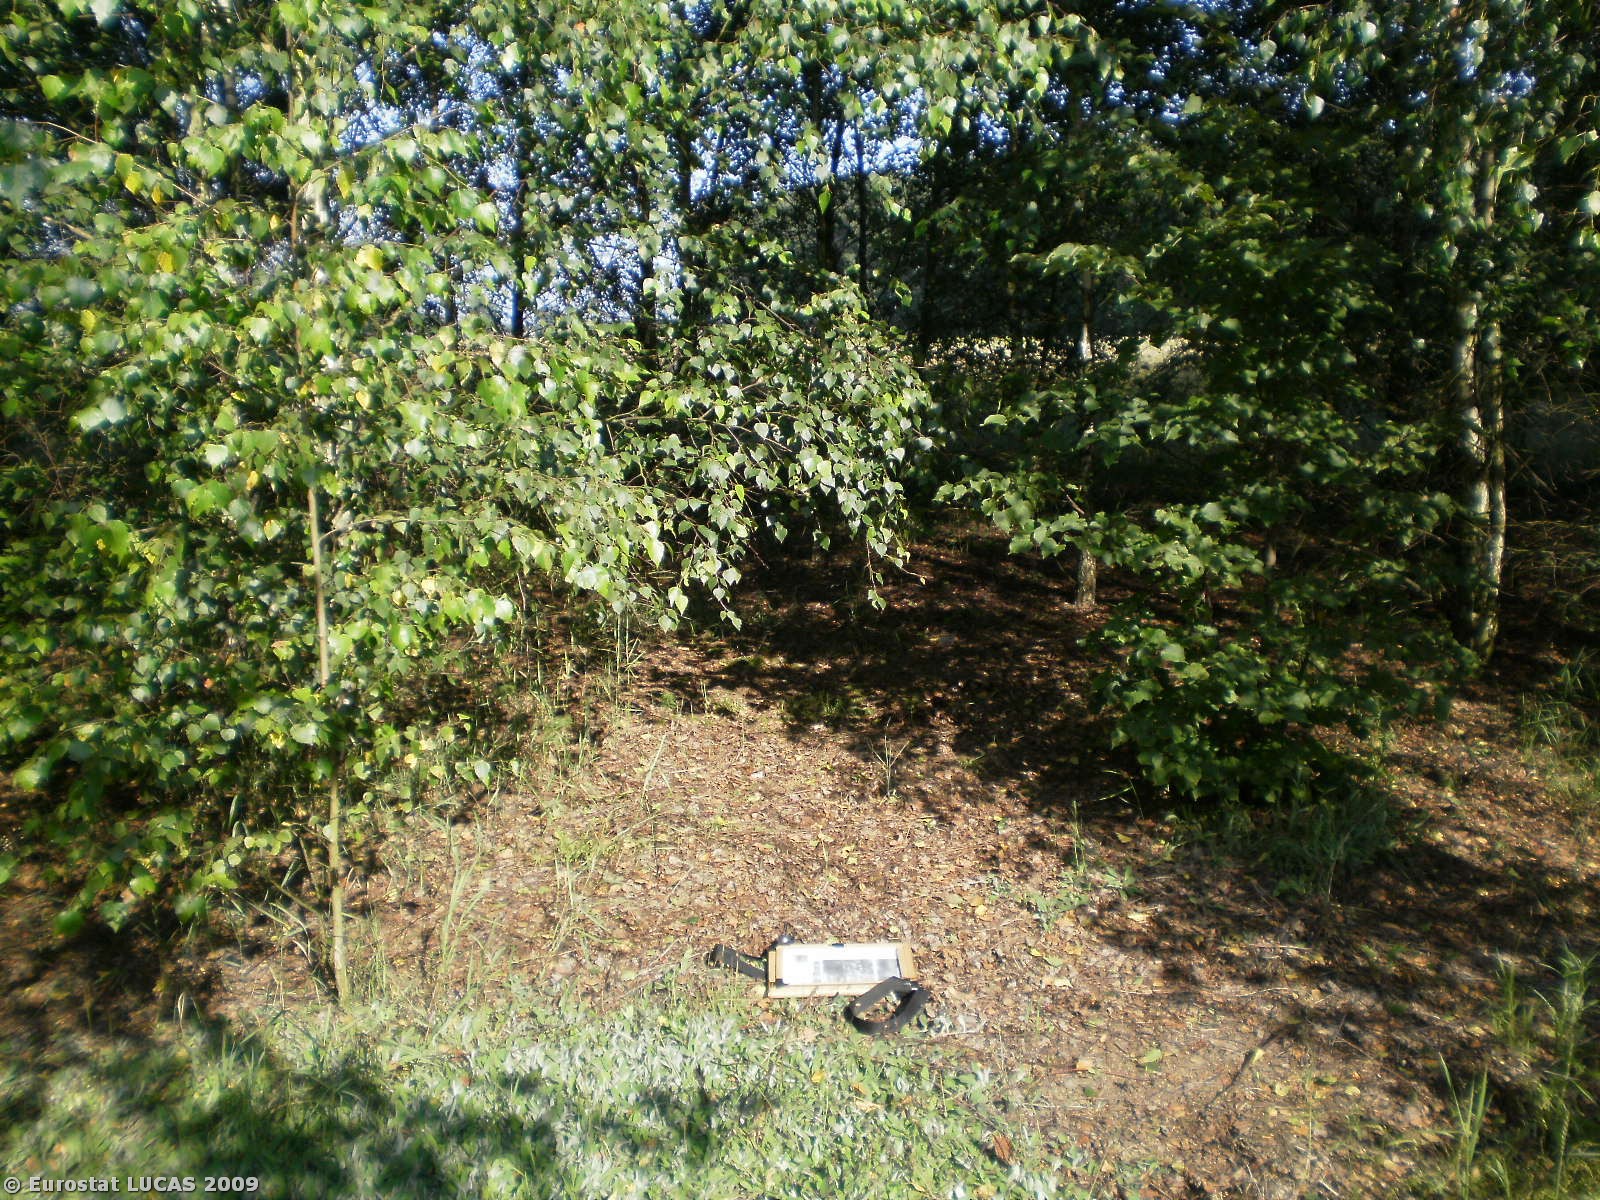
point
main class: Woodland
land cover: Broadleaved woodland
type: mesophytic deciduous forest
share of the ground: > 75 %
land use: Forestry
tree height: > 5 m
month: July
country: PL
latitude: 52.7743
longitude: 20.3683
